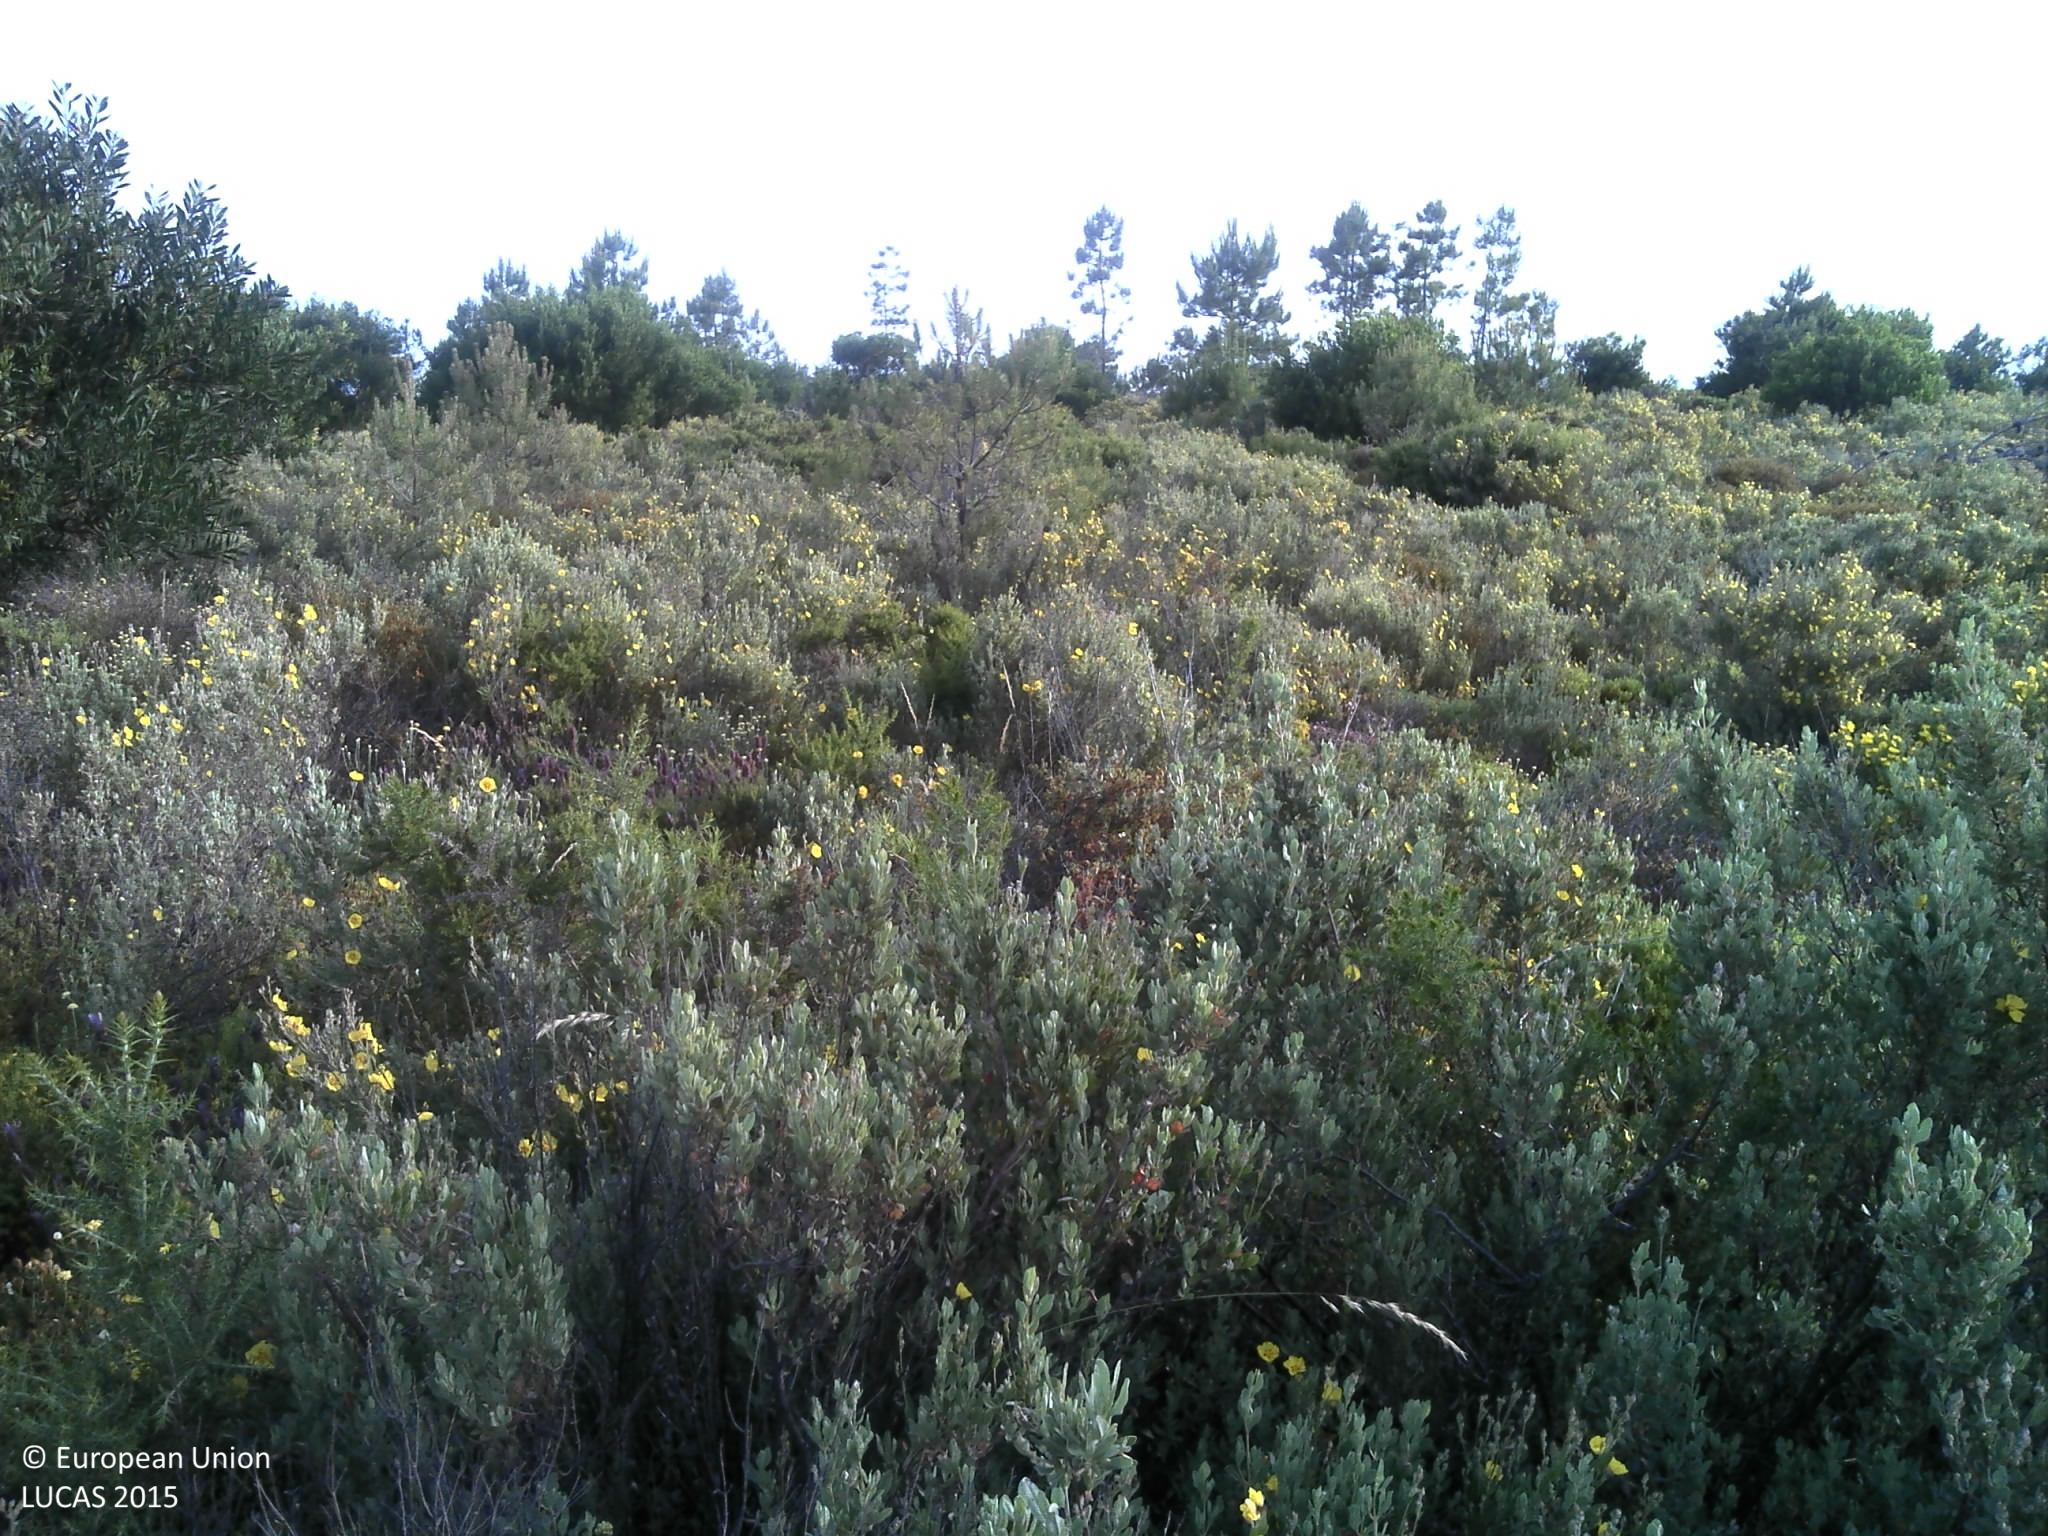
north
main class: Shrubland
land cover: Shrubland with sparse tree cover
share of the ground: 50 - 75 %
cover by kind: shrubs 60 %, herbaceous plants 25 %, consolidated bare surface 10 %, coniferous forest trees 5 %
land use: Semi-natural and natural areas not in use
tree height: < 5 m
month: May
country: PT
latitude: 37.6351
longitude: -8.7974
